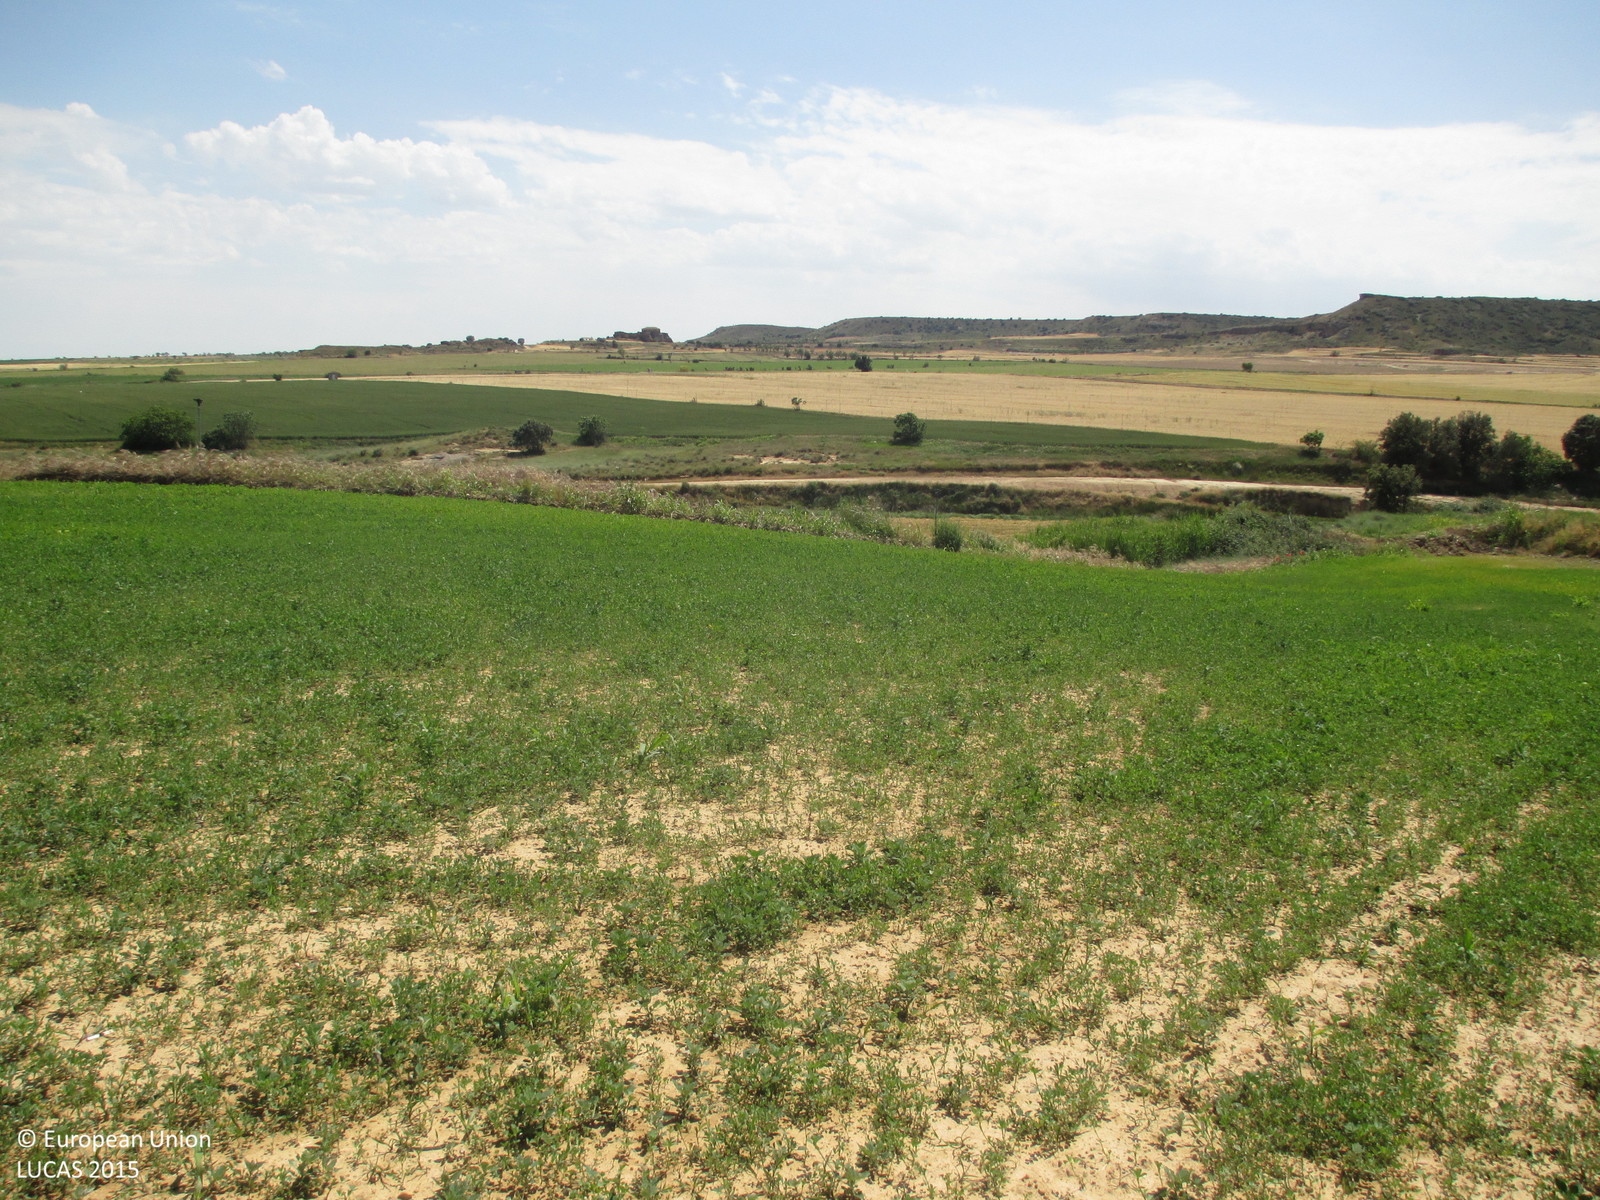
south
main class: Cropland
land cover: Lucerne
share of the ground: > 75 %
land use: Agriculture (excluding fallow land and kitchen gardens)
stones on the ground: < 10 %
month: May
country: ES
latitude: 41.9390
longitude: -0.1871
